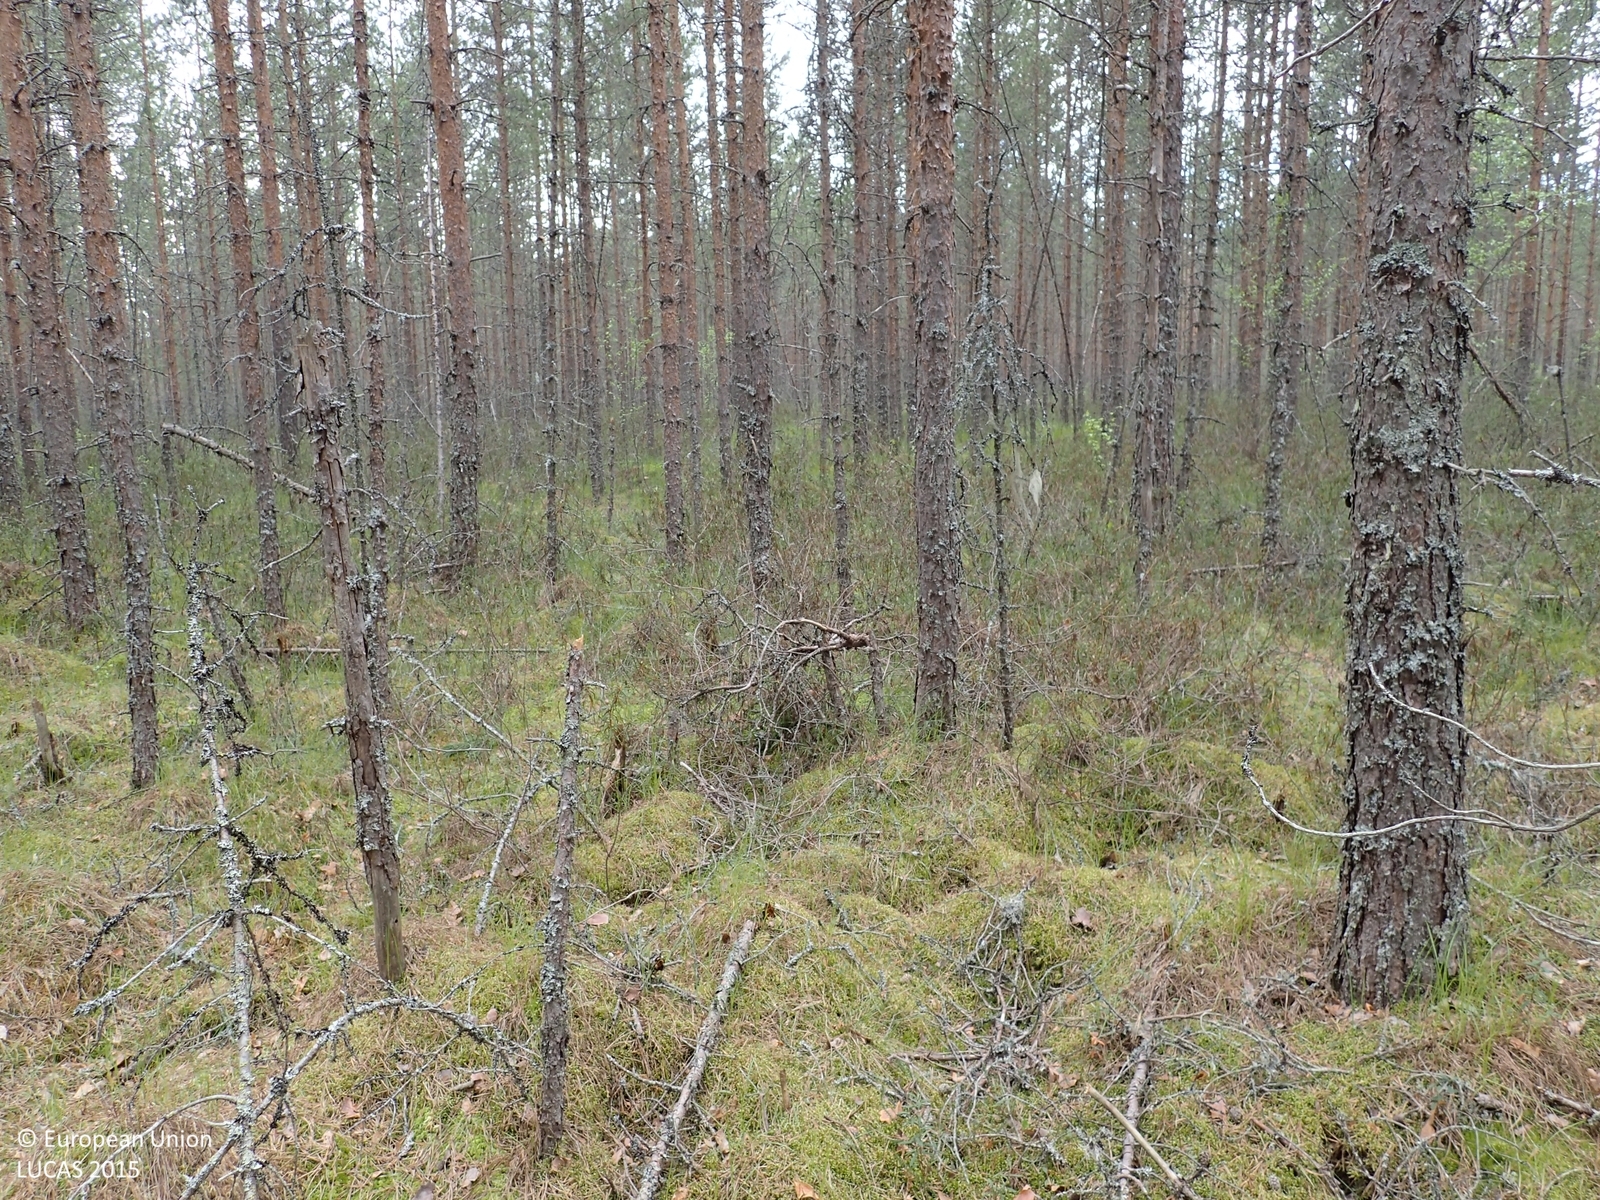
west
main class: Woodland
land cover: Pine dominated coniferous woodland
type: boreal forest
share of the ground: > 75 %
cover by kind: coniferous forest trees 80 %, shrubs 10 %, broadleaved forest trees 5 %, lichens and mosses 5 %
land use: Forestry
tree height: > 5 m
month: June
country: FI
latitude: 62.2375
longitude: 21.8067
